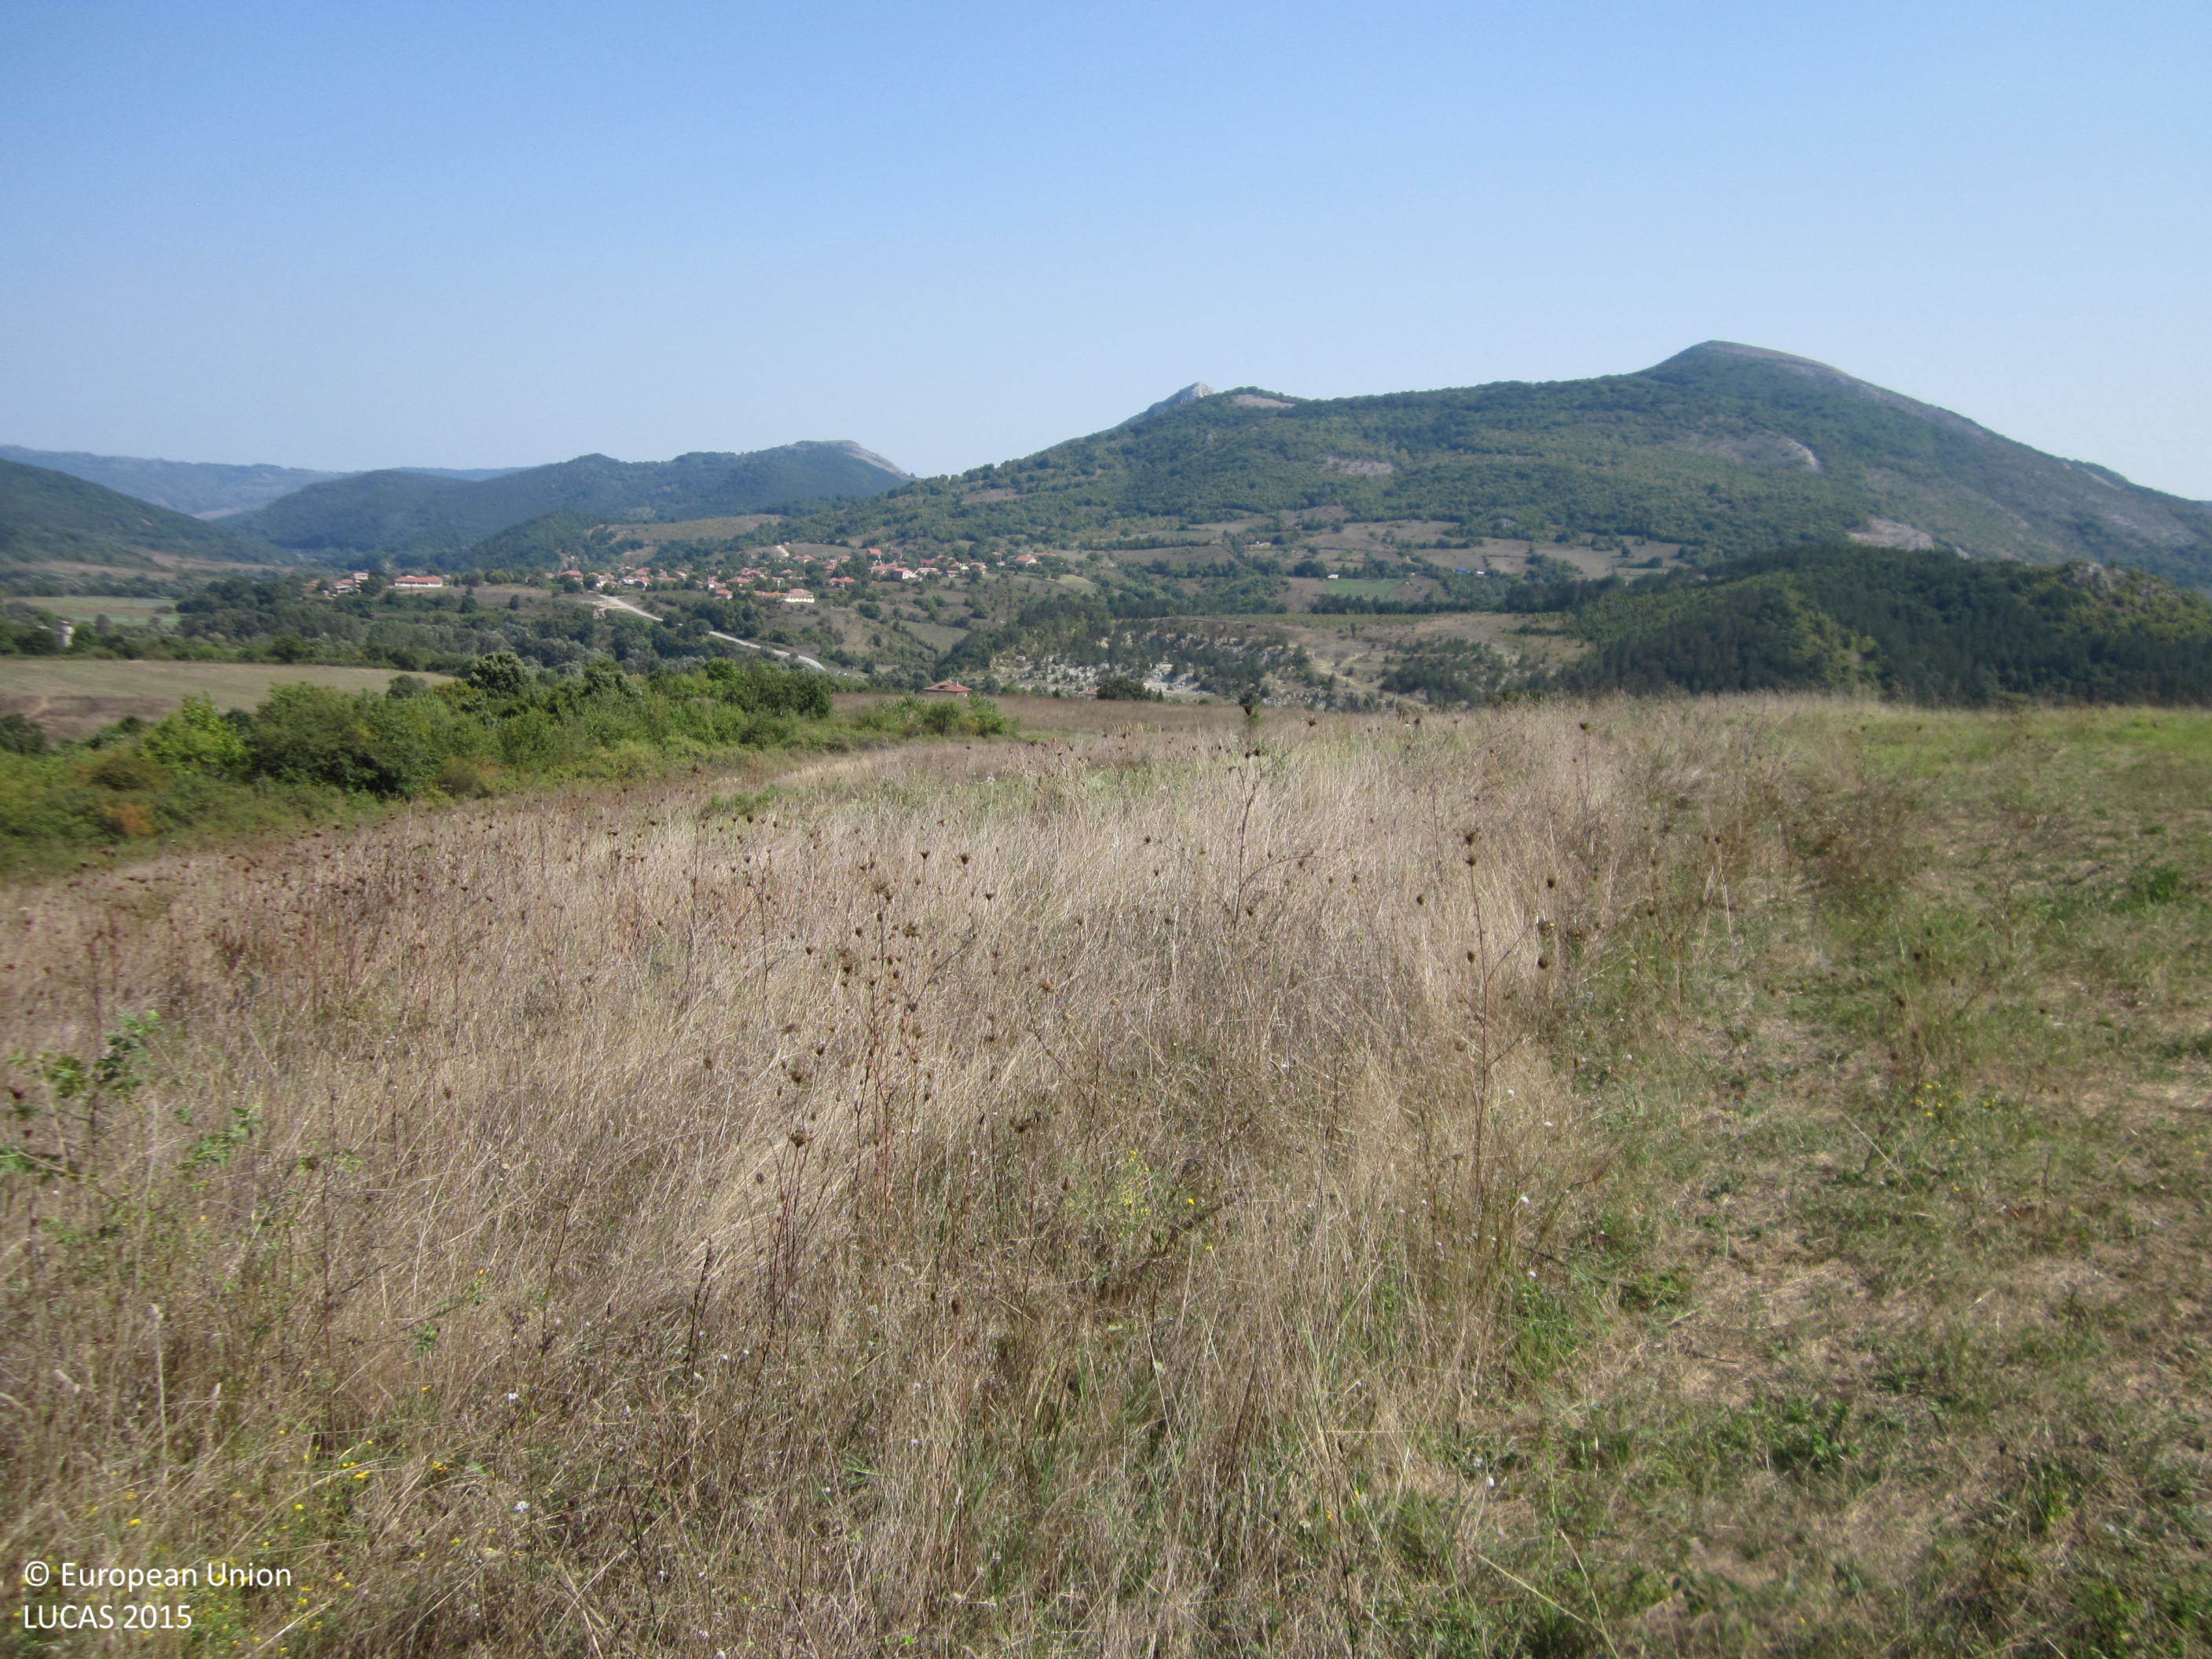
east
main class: Grassland
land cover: Grassland with sparse tree/shrub cover
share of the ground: > 75 %
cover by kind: herbaceous plants 90 %, broadleaved forest trees 5 %, shrubs 5 %
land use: Agriculture (excluding fallow land and kitchen gardens)
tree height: < 5 m
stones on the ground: < 10 %
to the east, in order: Grassland with sparse tree/shrub cover; Broadleaved woodland; Shrubland with sparse tree cover; Grassland with sparse tree/shrub cover; Broadleaved woodland; Shruby margins; Grassland with sparse tree/shrub cover
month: September
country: BG
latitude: 42.9362
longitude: 27.2103
